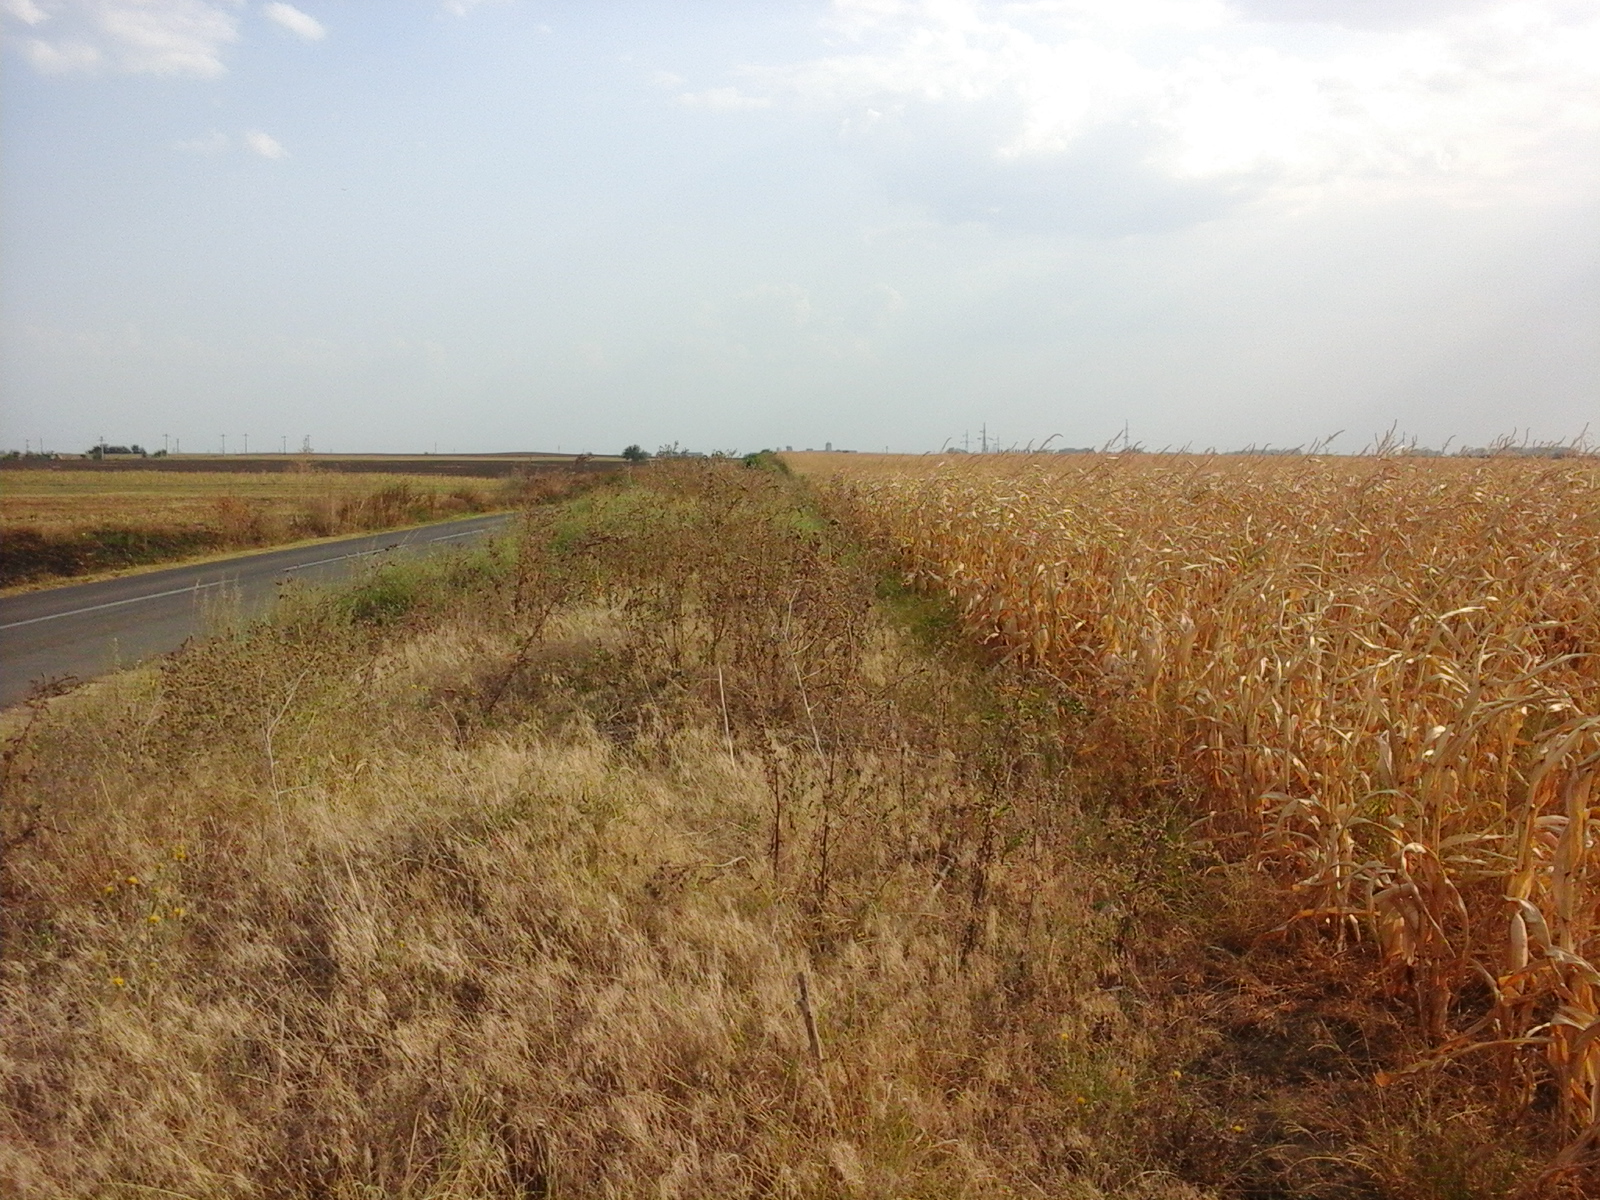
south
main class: Cropland
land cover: Maize
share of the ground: > 75 %
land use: Agriculture (excluding fallow land and kitchen gardens)
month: August
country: RO
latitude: 44.0655
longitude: 23.3687
